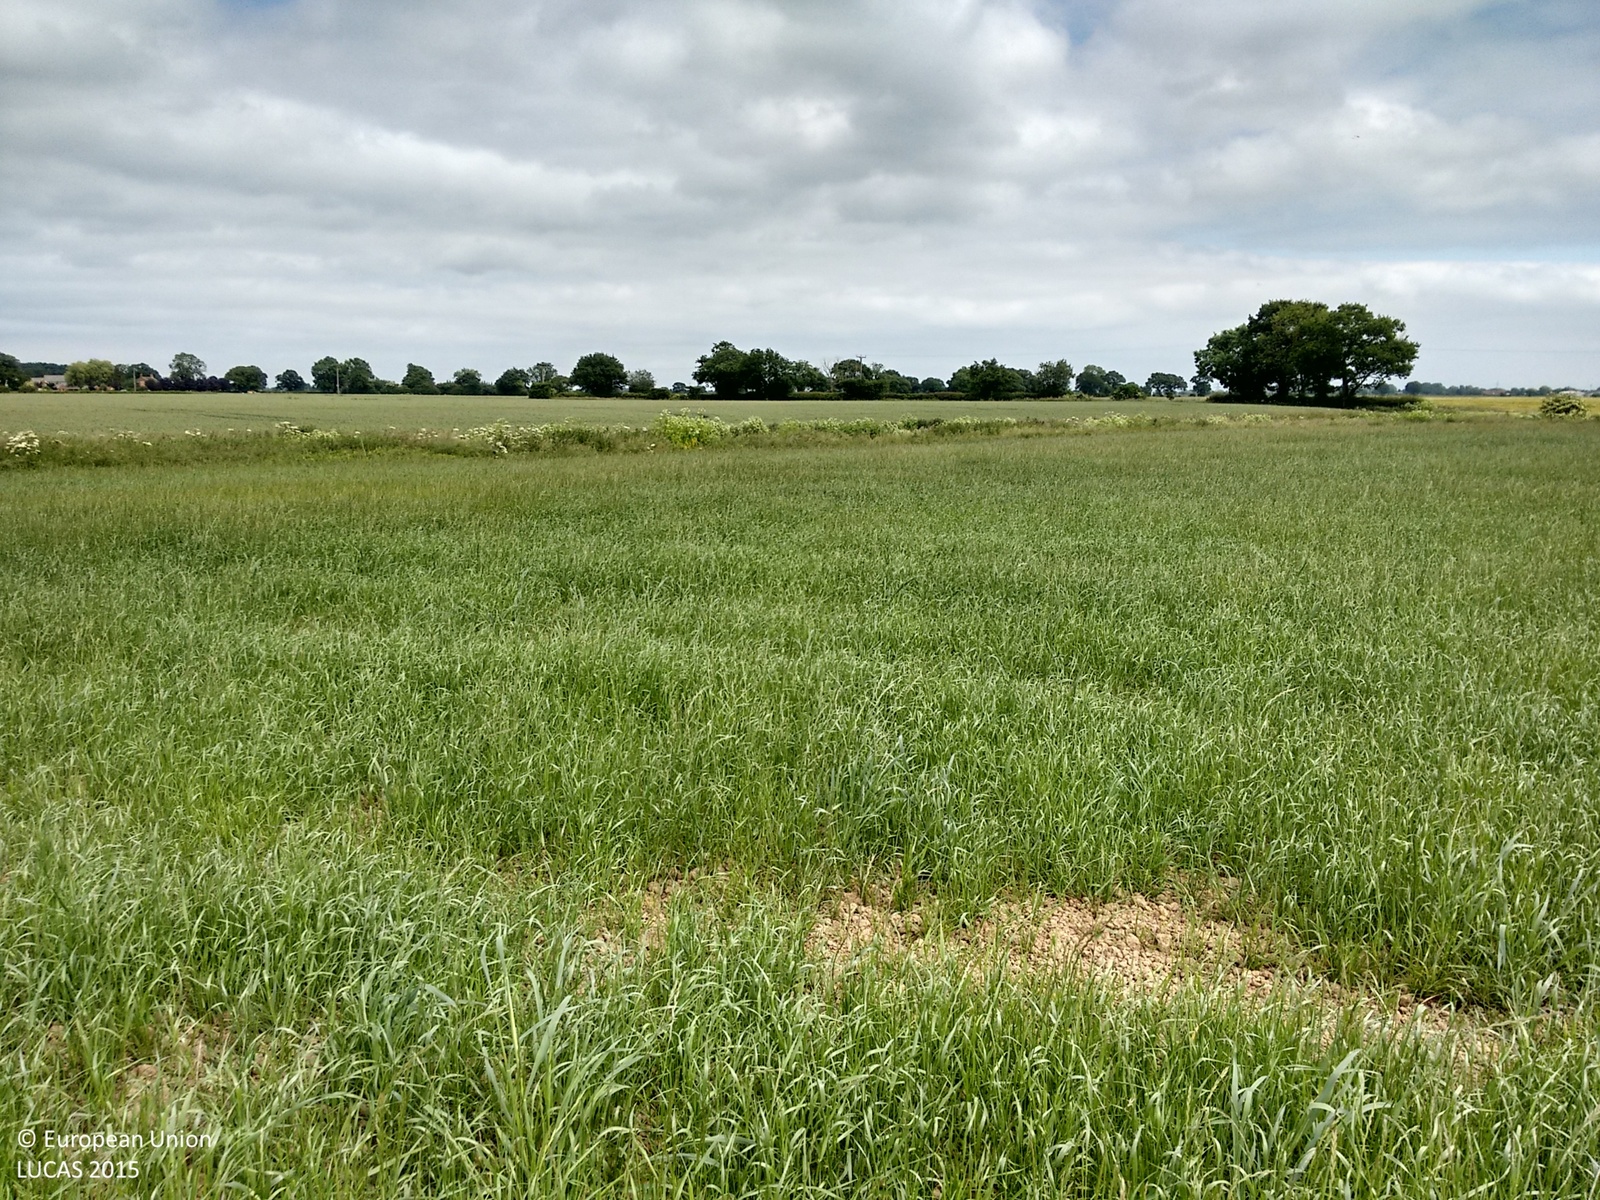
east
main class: Cropland
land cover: Barley
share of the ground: > 75 %
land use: Agriculture (excluding fallow land and kitchen gardens)
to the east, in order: Barley; Grassland with sparse tree/shrub cover; Rivers and streams; Grass margins; Common wheat; Managed hedges; Arable land (only in case pi)
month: June
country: GB
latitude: 53.6493
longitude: -1.1342
